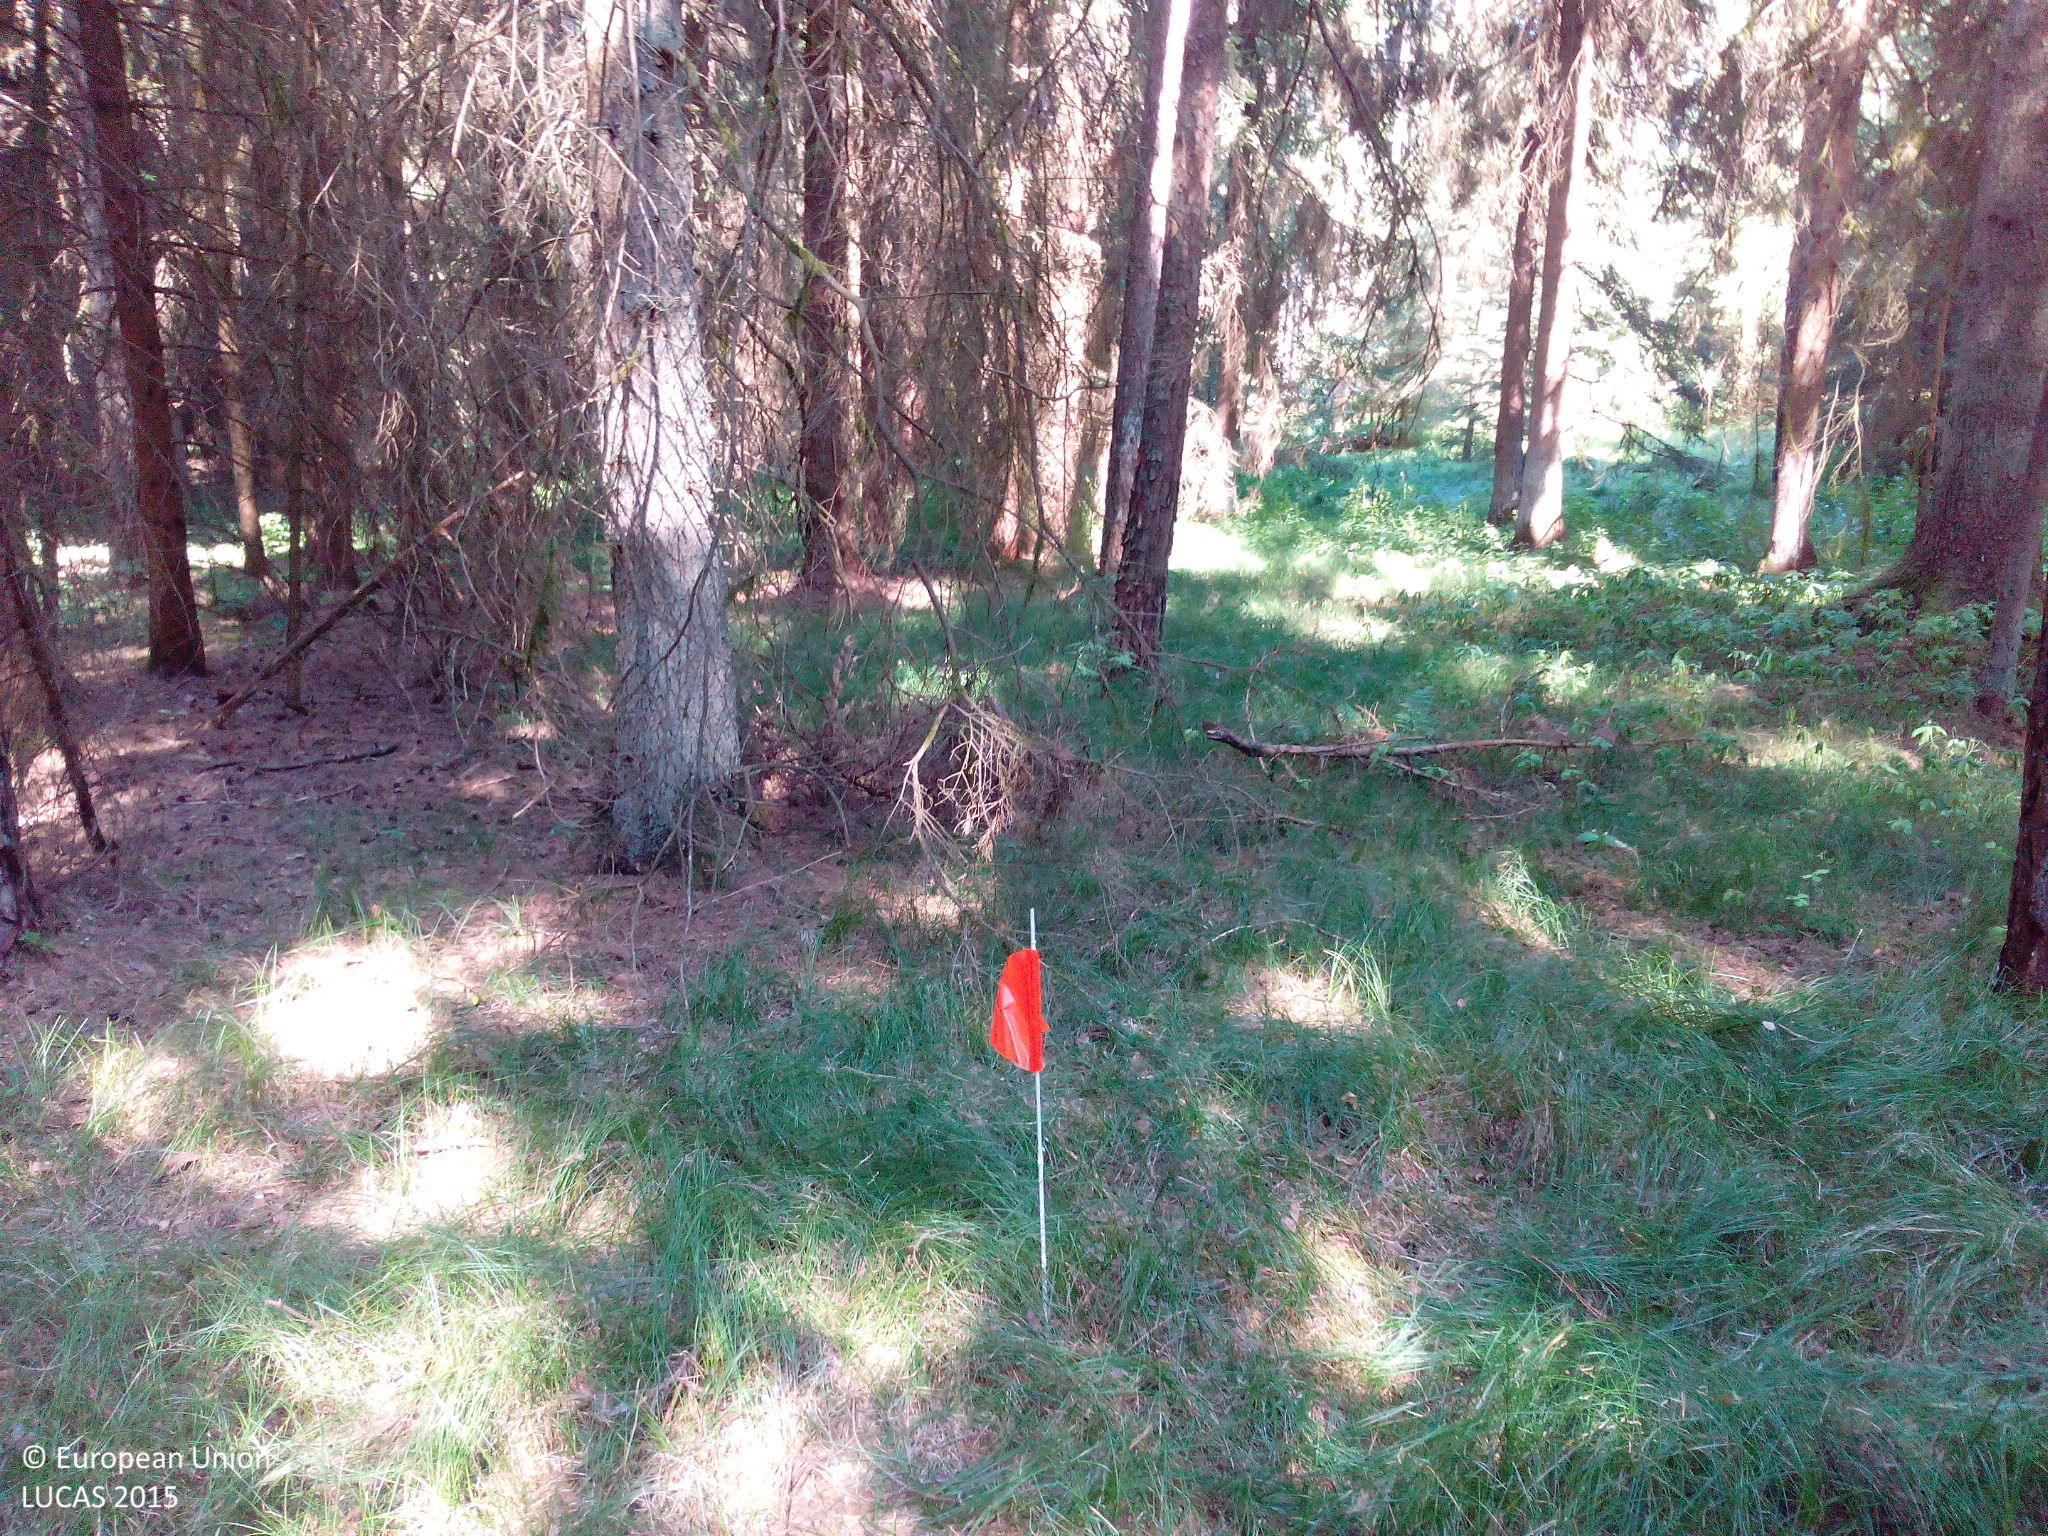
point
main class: Woodland
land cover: Other coniferous woodland
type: hemiboreal forest and nemoral coniferous forest and mixed broadleaved-coniferous forest
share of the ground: > 75 %
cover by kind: coniferous forest trees 85 %, herbaceous plants 10 %, unconsolidated bare surface 5 %
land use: Forestry
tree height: > 5 m
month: July
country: DE
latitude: 49.3534
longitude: 10.8945
